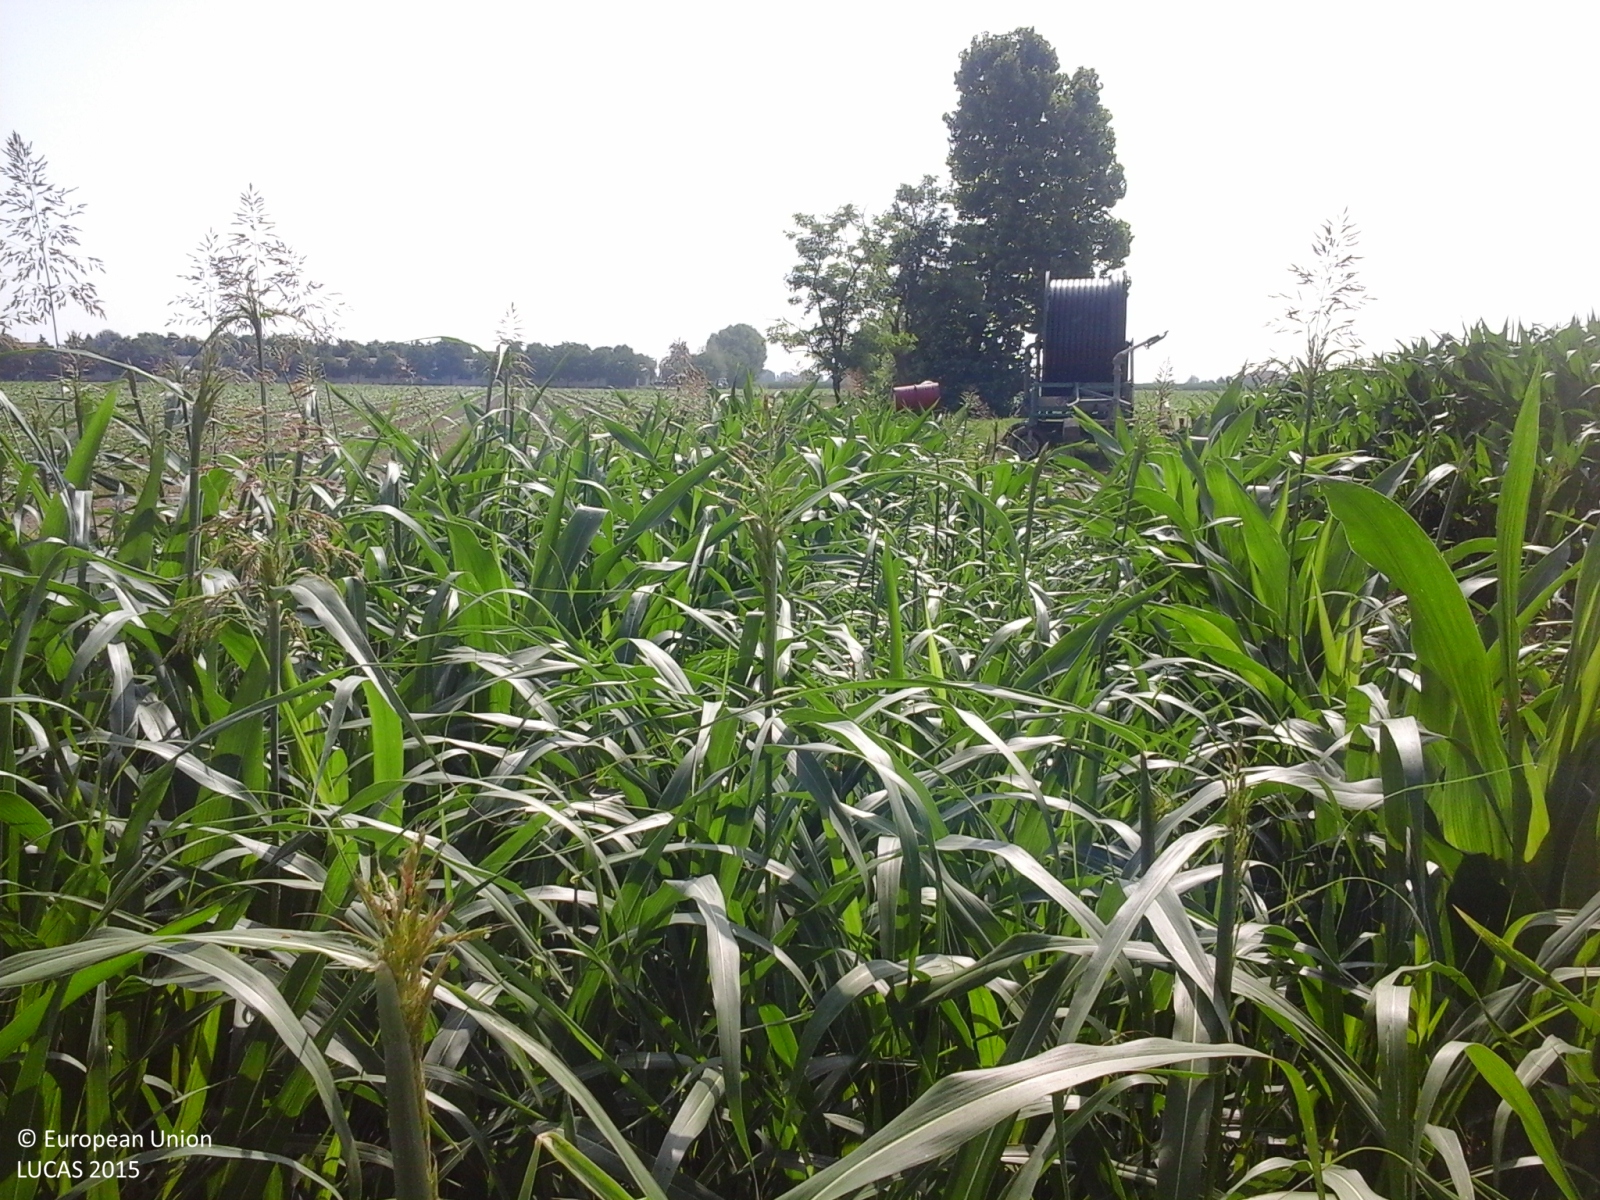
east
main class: Cropland
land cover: Maize
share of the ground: > 75 %
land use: Agriculture (excluding fallow land and kitchen gardens)
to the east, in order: Maize; Other bare soil; Ditches and canals; Managed hedges; Ditches and canals; Other bare soil; Ditches and canals; Tobacco
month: June
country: IT
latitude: 45.2102
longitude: 11.1057
